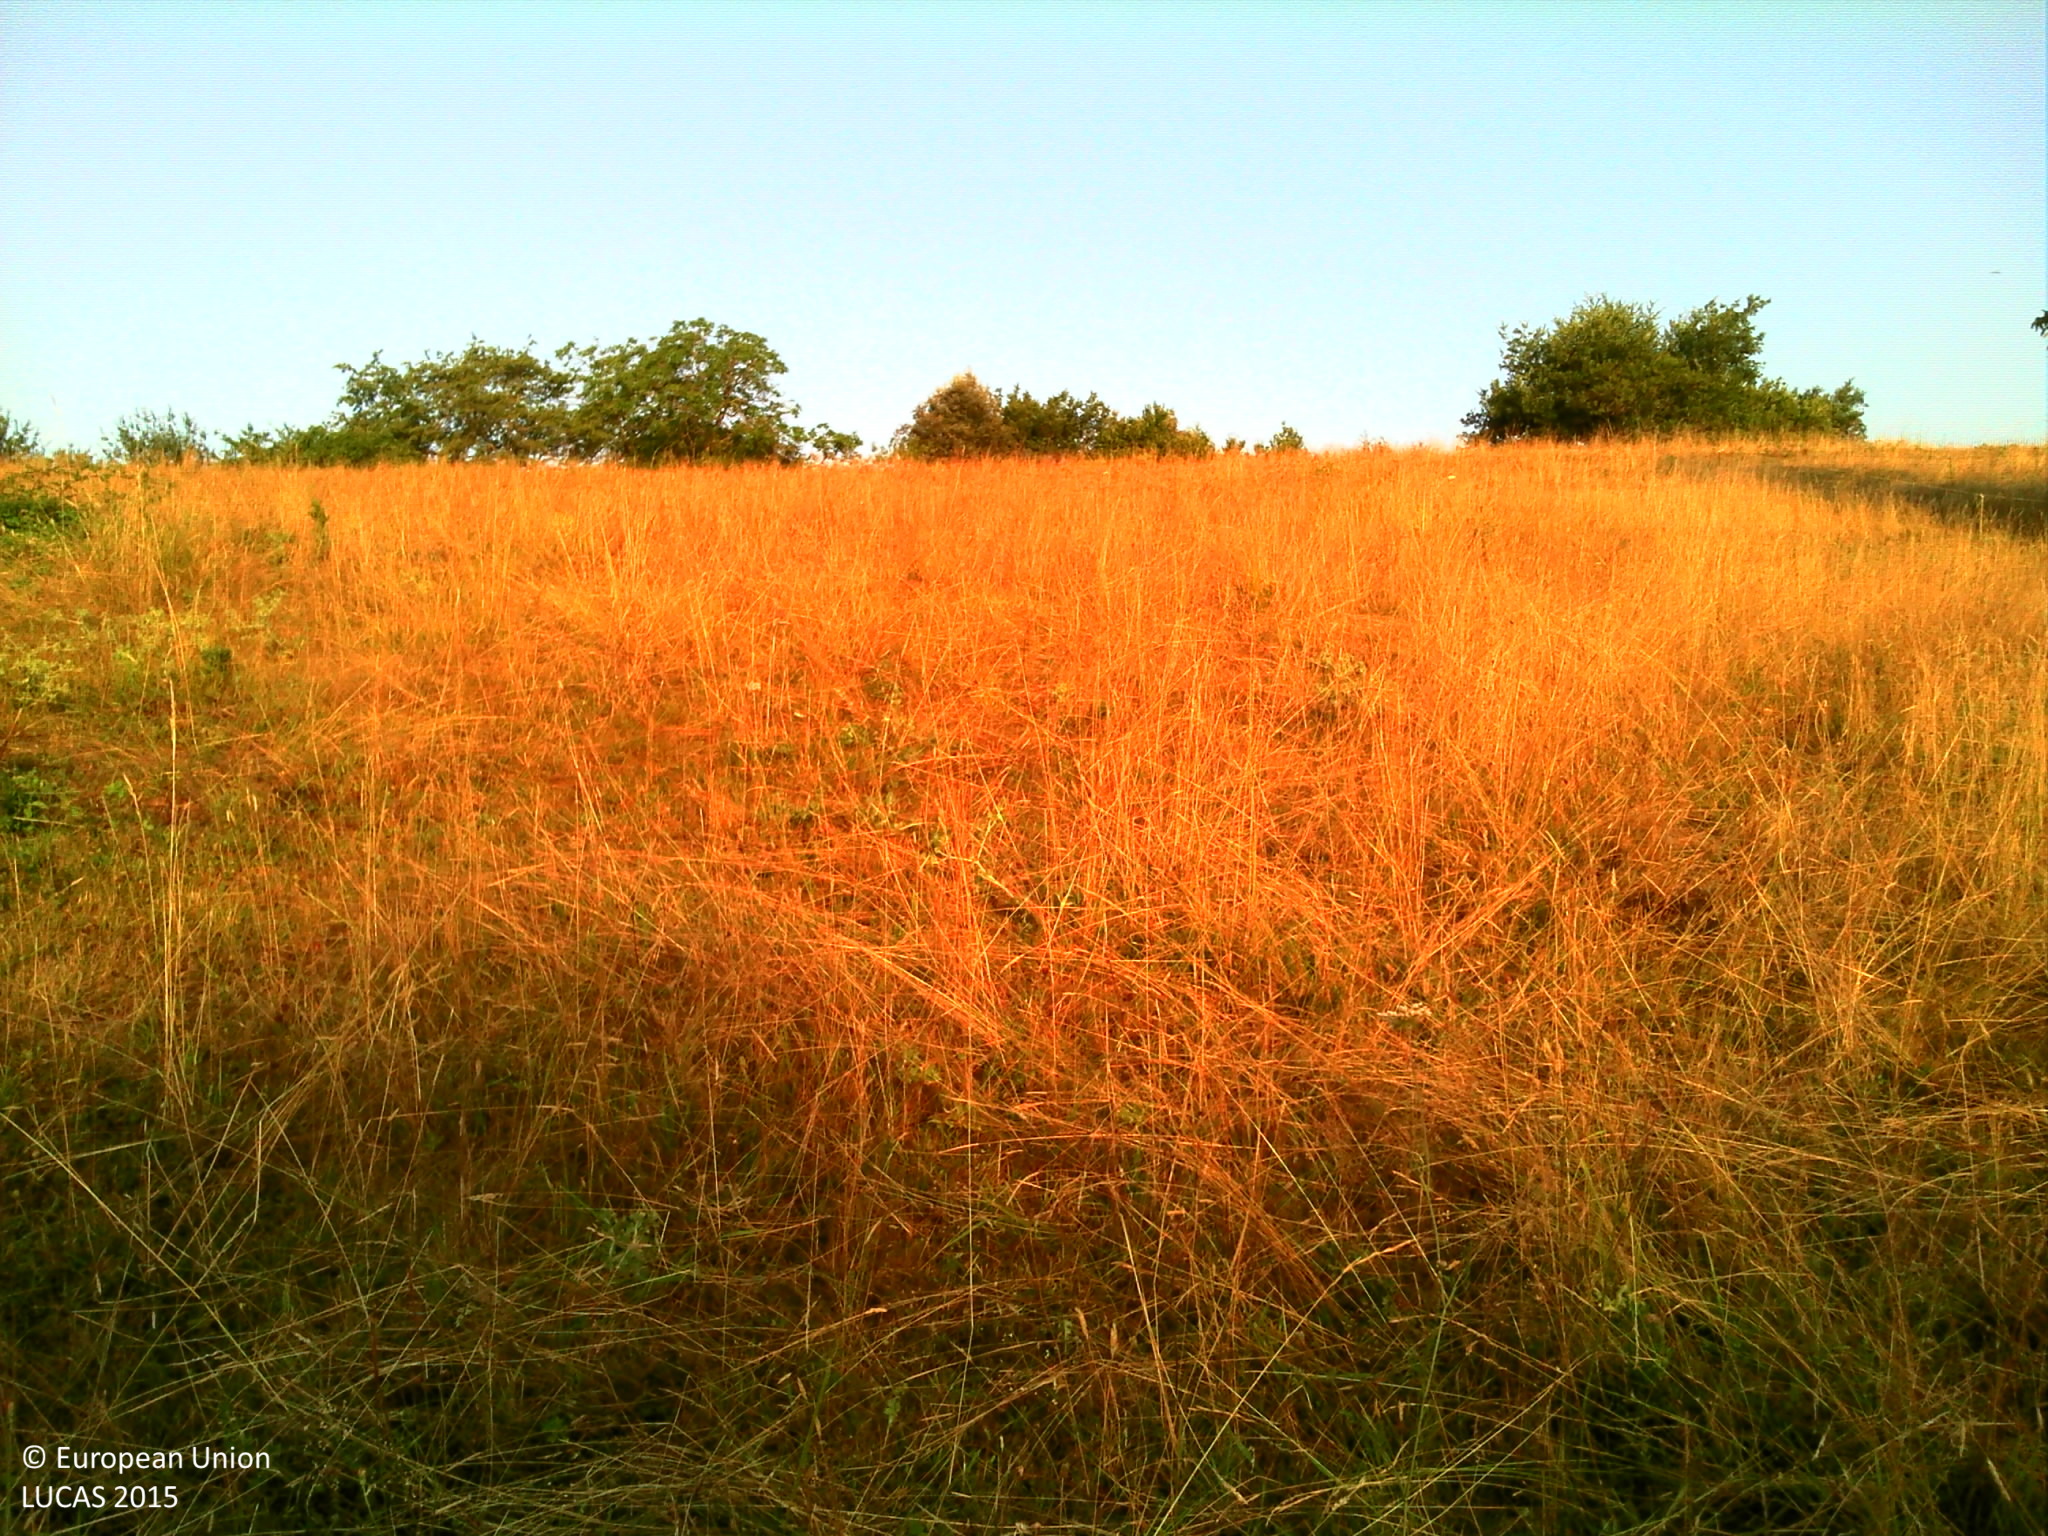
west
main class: Grassland
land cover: Grassland without tree/shrub cover
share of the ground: > 75 %
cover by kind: herbaceous plants 100 %
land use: Agriculture (excluding fallow land and kitchen gardens)
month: July
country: FR
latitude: 45.0769
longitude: 1.1395
